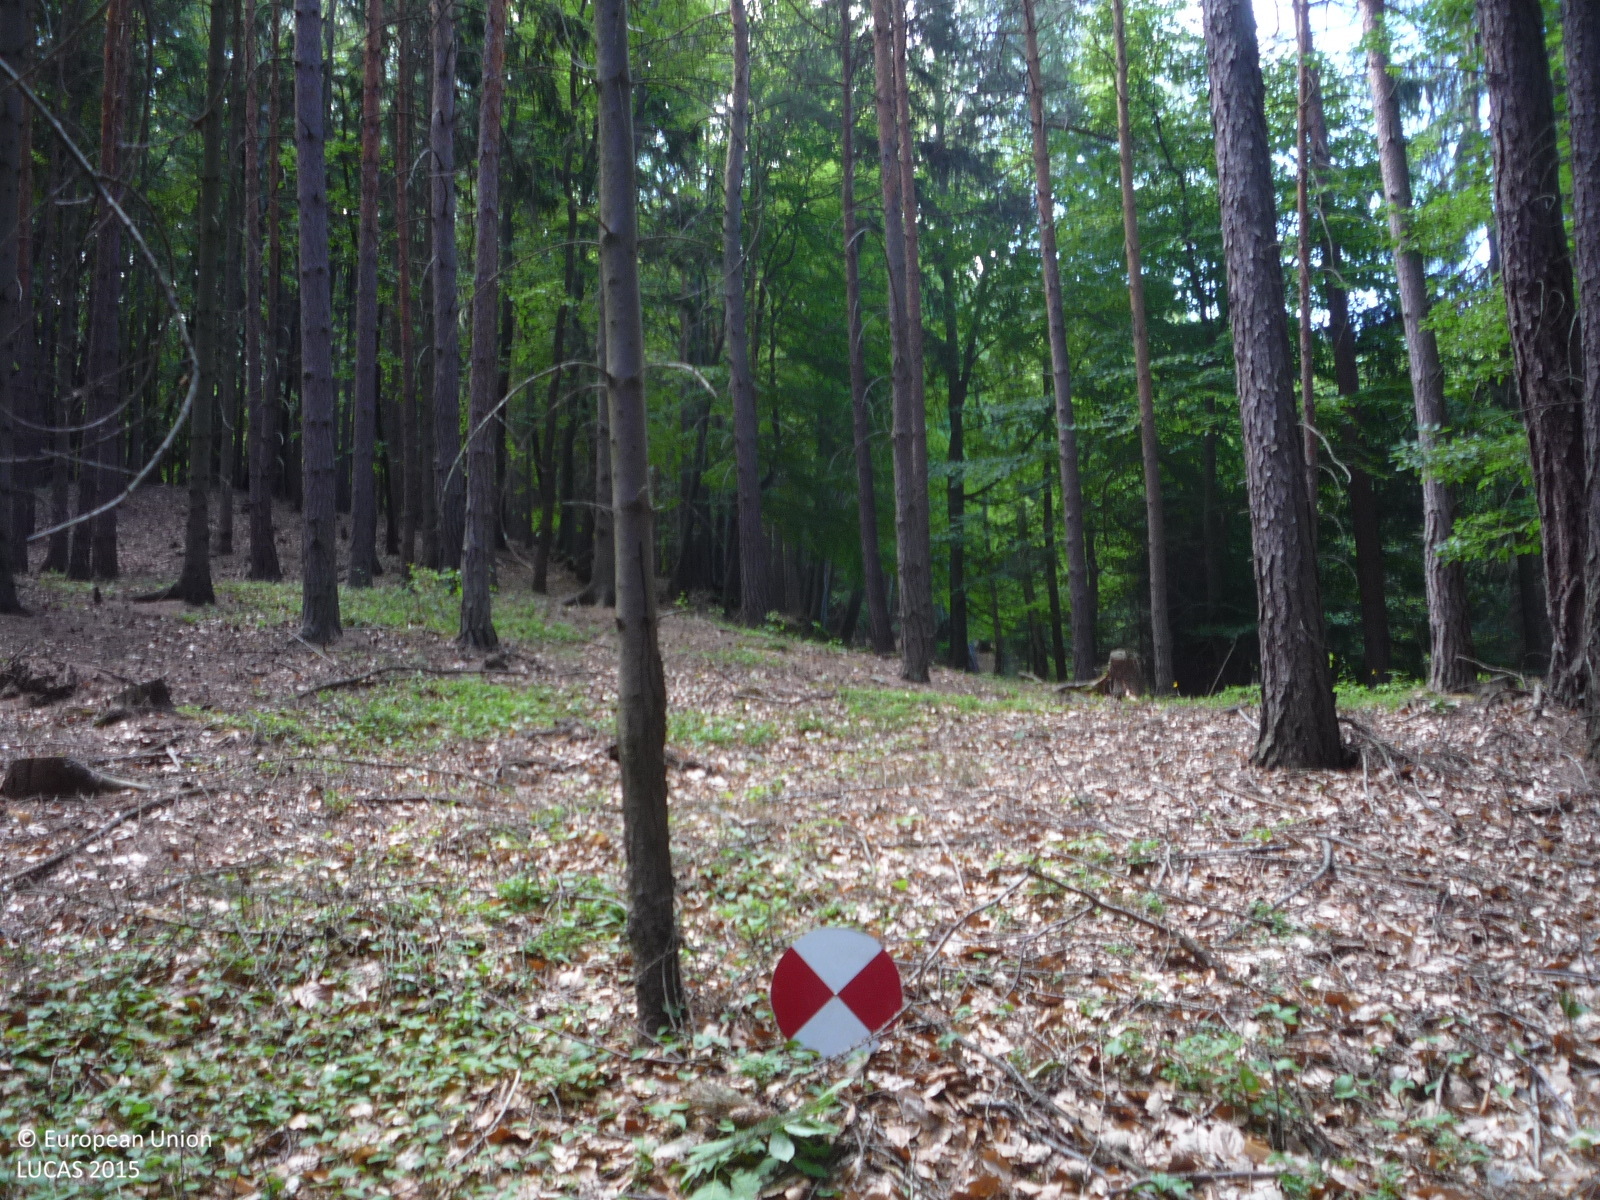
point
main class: Woodland
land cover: Other mixed woodland
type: hemiboreal forest and nemoral coniferous forest and mixed broadleaved-coniferous forest
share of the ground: > 75 %
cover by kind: coniferous forest trees 60 %, broadleaved forest trees 30 %, herbaceous plants 5 %, unconsolidated bare surface 5 %
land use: Forestry
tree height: > 5 m
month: June
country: CZ
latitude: 50.2092
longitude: 13.8541
